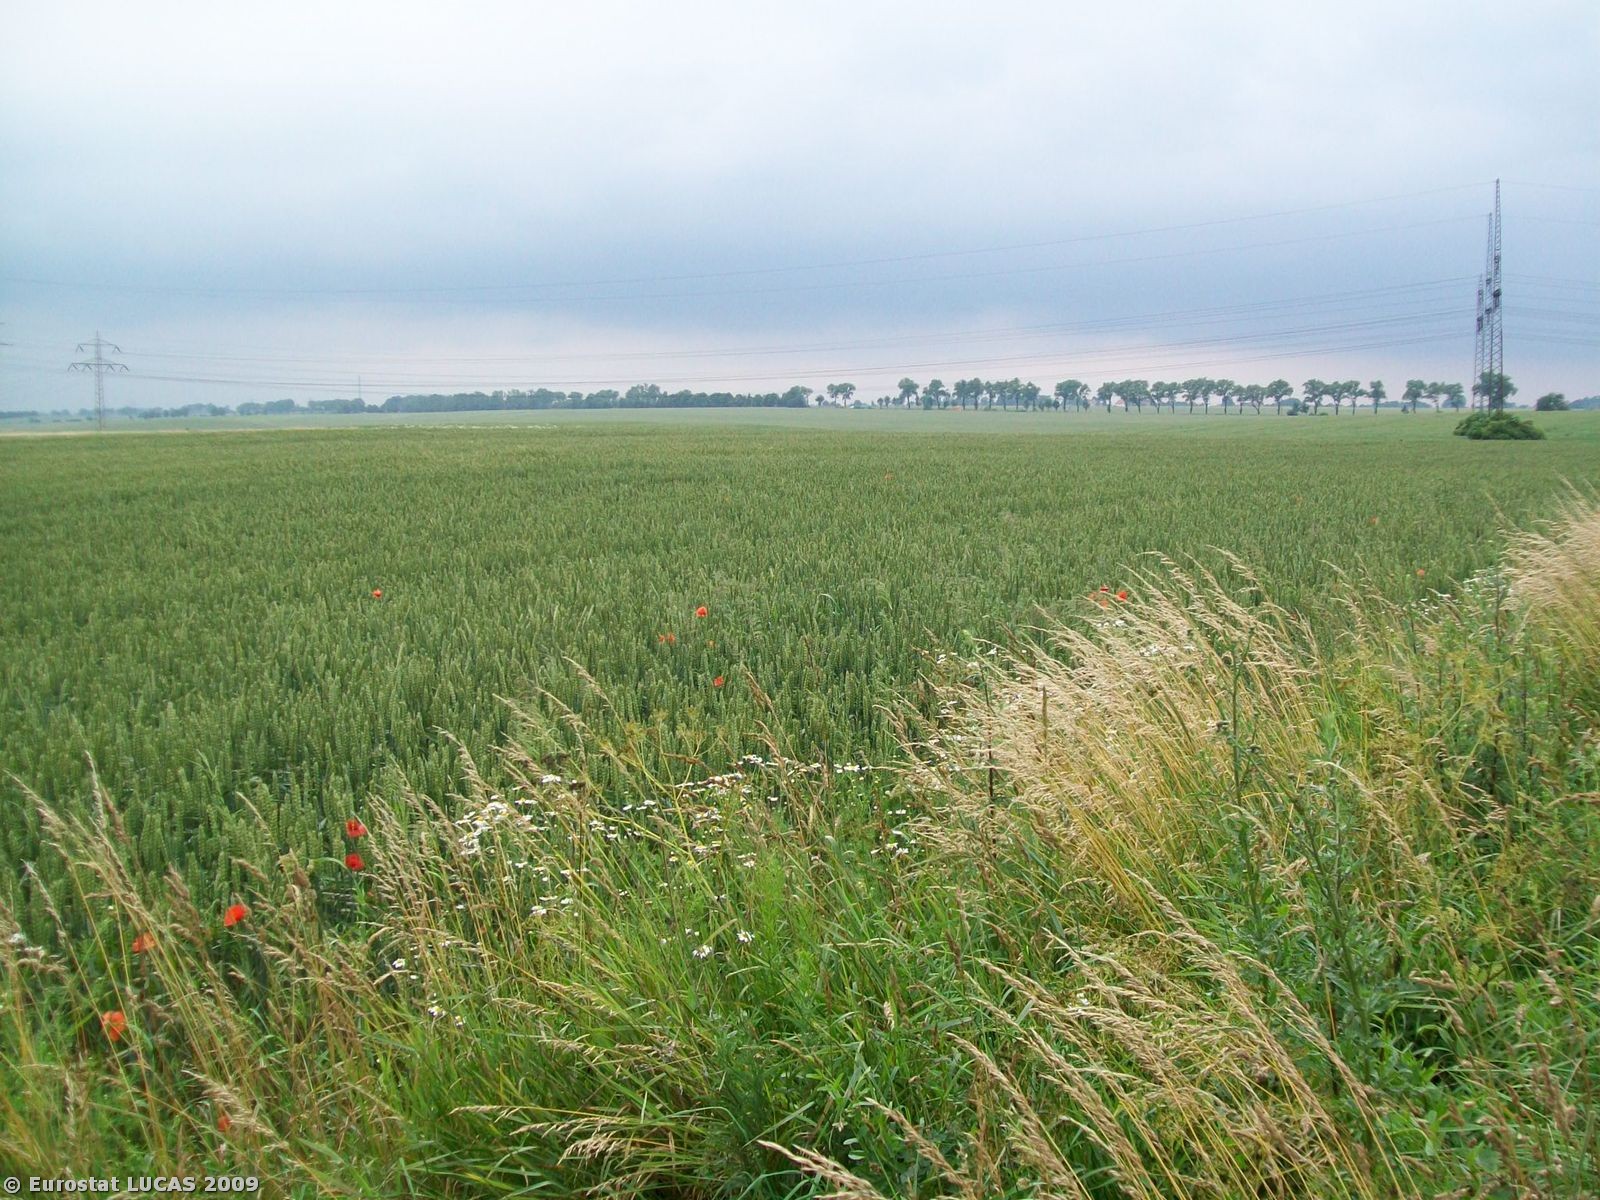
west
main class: Cropland
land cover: Common wheat
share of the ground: > 75 %
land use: Agriculture (excluding fallow land and kitchen gardens)
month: June
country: PL
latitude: 51.1757
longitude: 16.0854
